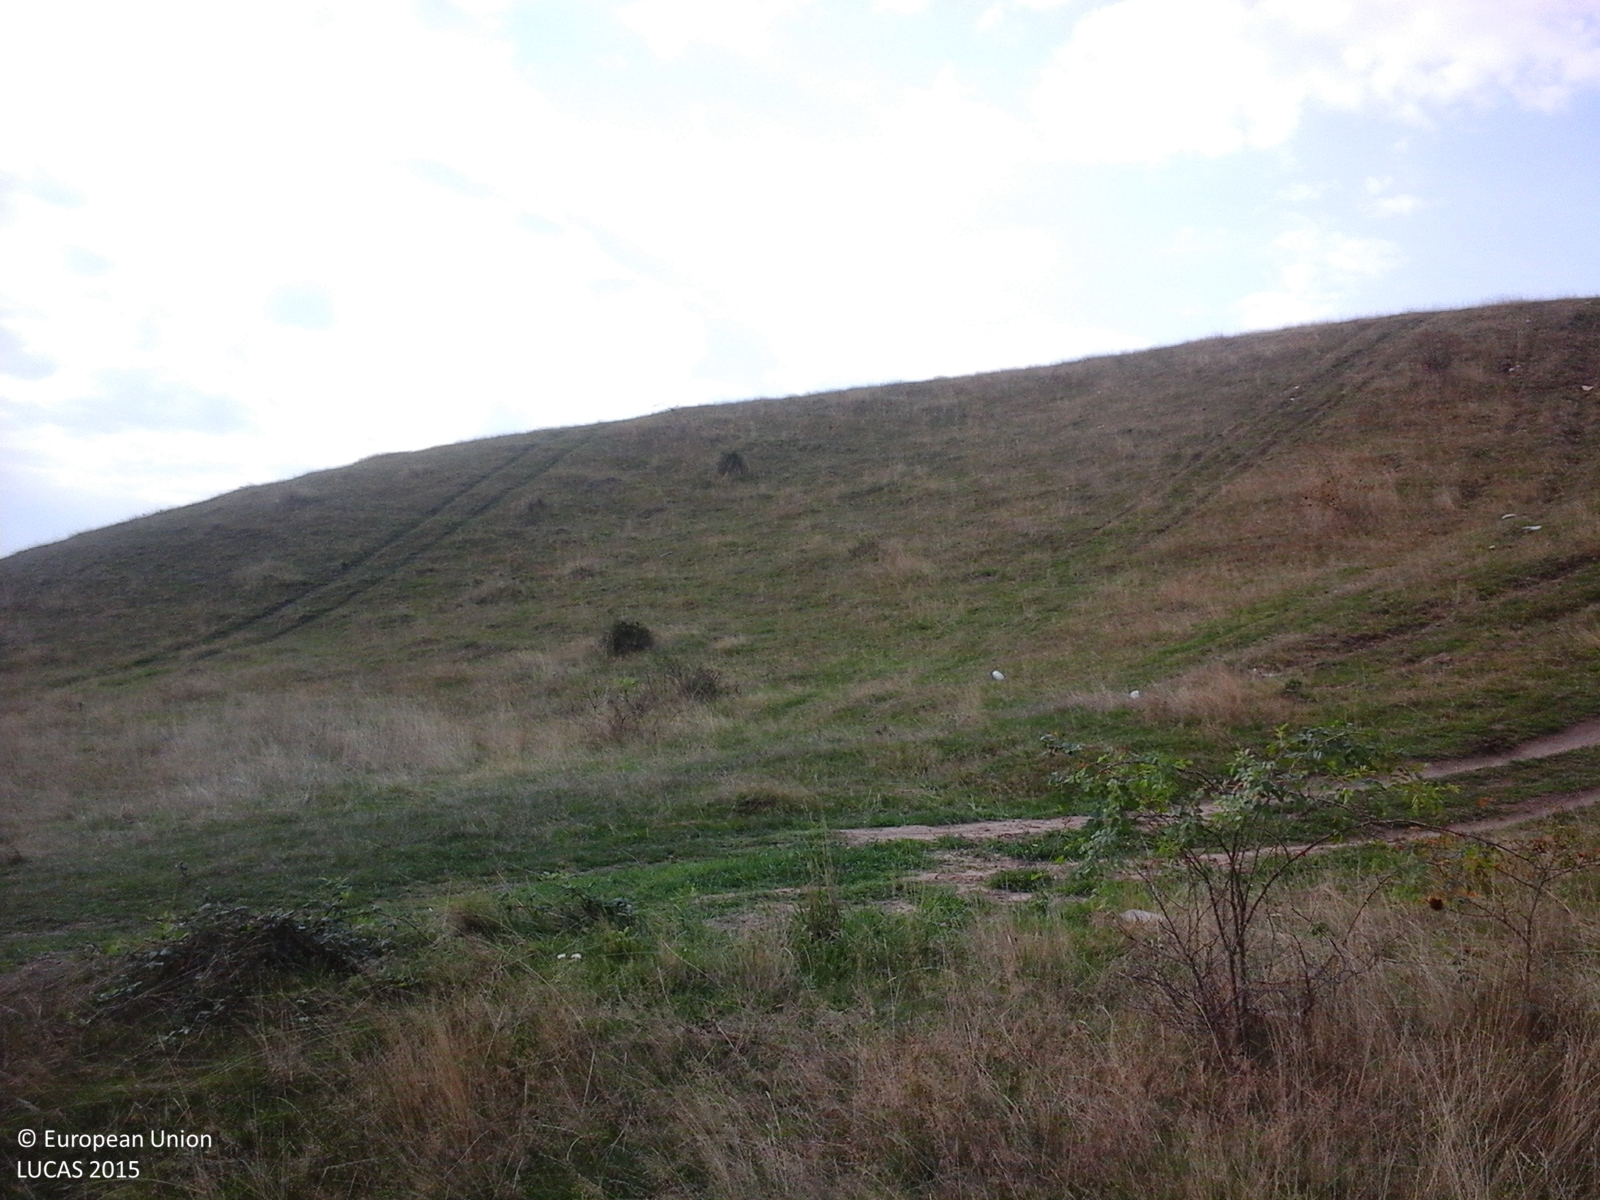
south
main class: Grassland
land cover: Grassland without tree/shrub cover
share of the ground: > 75 %
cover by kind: herbaceous plants 100 %
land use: Agriculture (excluding fallow land and kitchen gardens)
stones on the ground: < 10 %
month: September
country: RO
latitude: 45.6930
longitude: 22.9071
